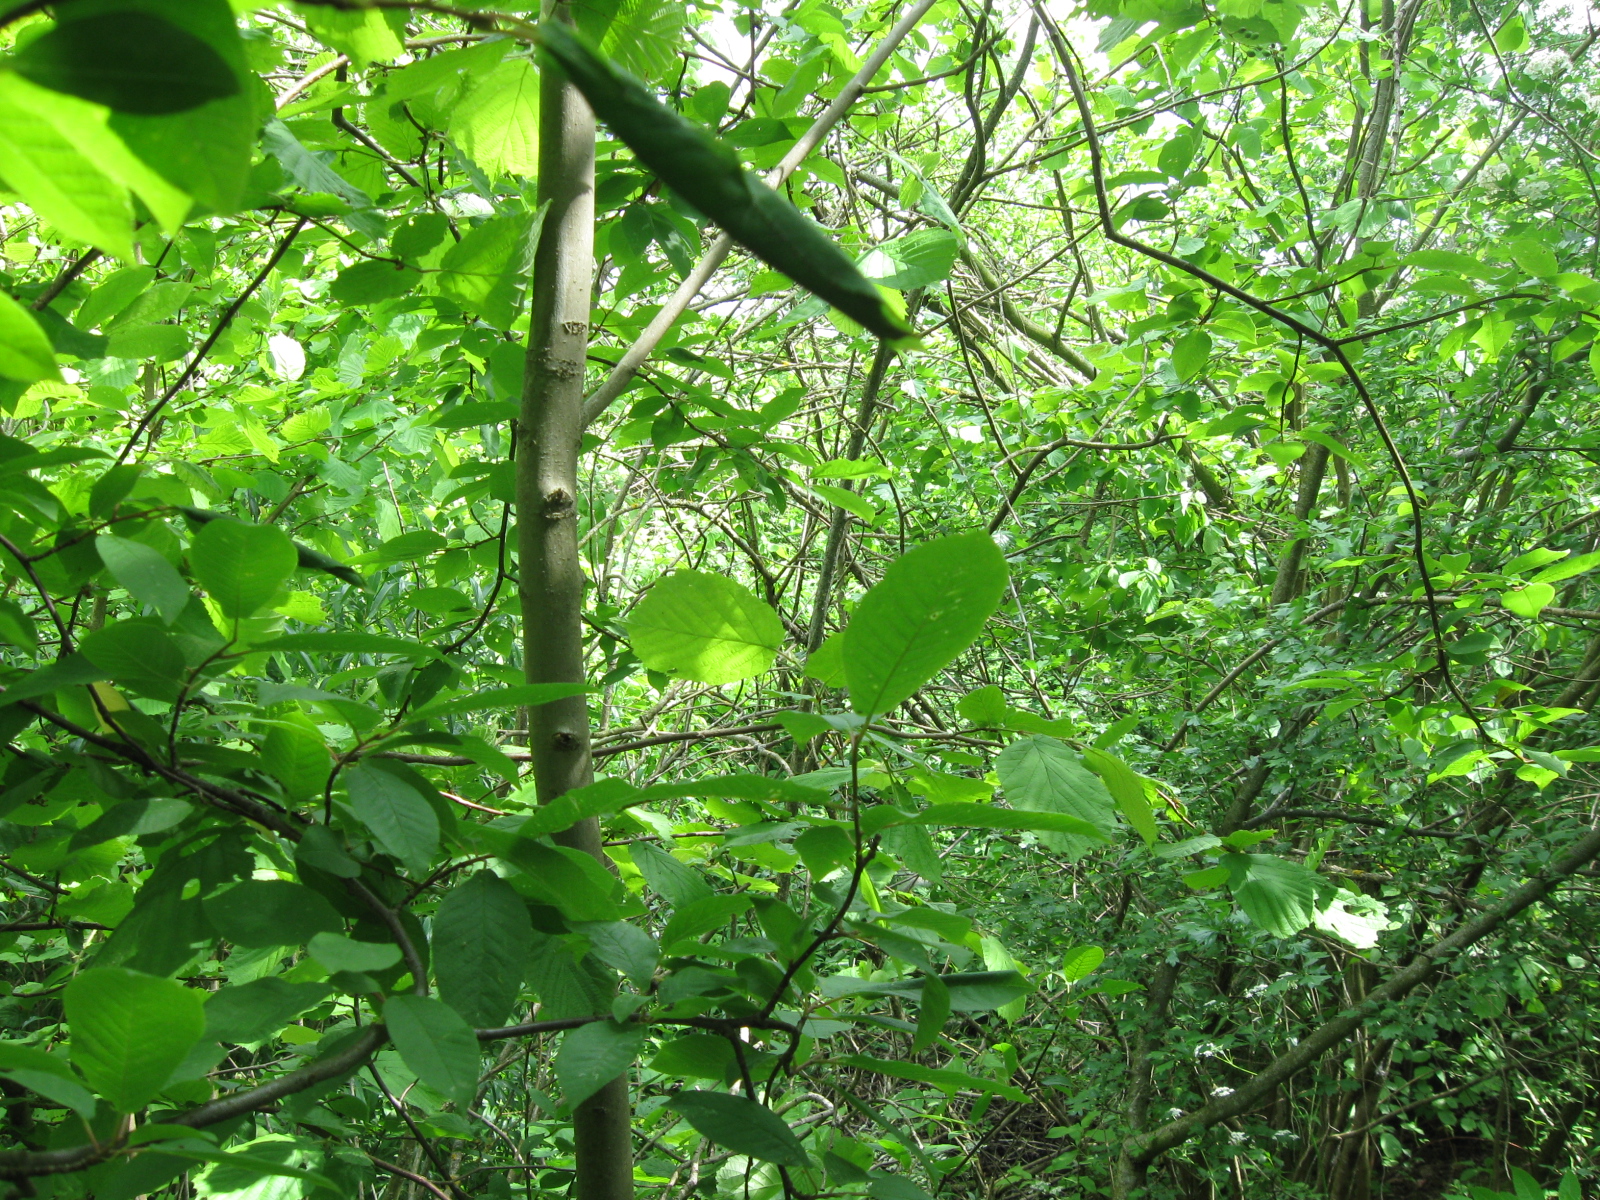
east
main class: Woodland
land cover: Broadleaved woodland
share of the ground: > 75 %
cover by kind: broadleaved forest trees 75 %, herbaceous plants 25 %
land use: Semi-natural and natural areas not in use
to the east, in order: Broadleaved woodland; Rivers and streams; Broadleaved woodland; Common wheat; Grassland without tree/shrub cover; Fences; Grassland without tree/shrub cover
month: June
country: LT
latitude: 54.3488
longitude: 23.7330
